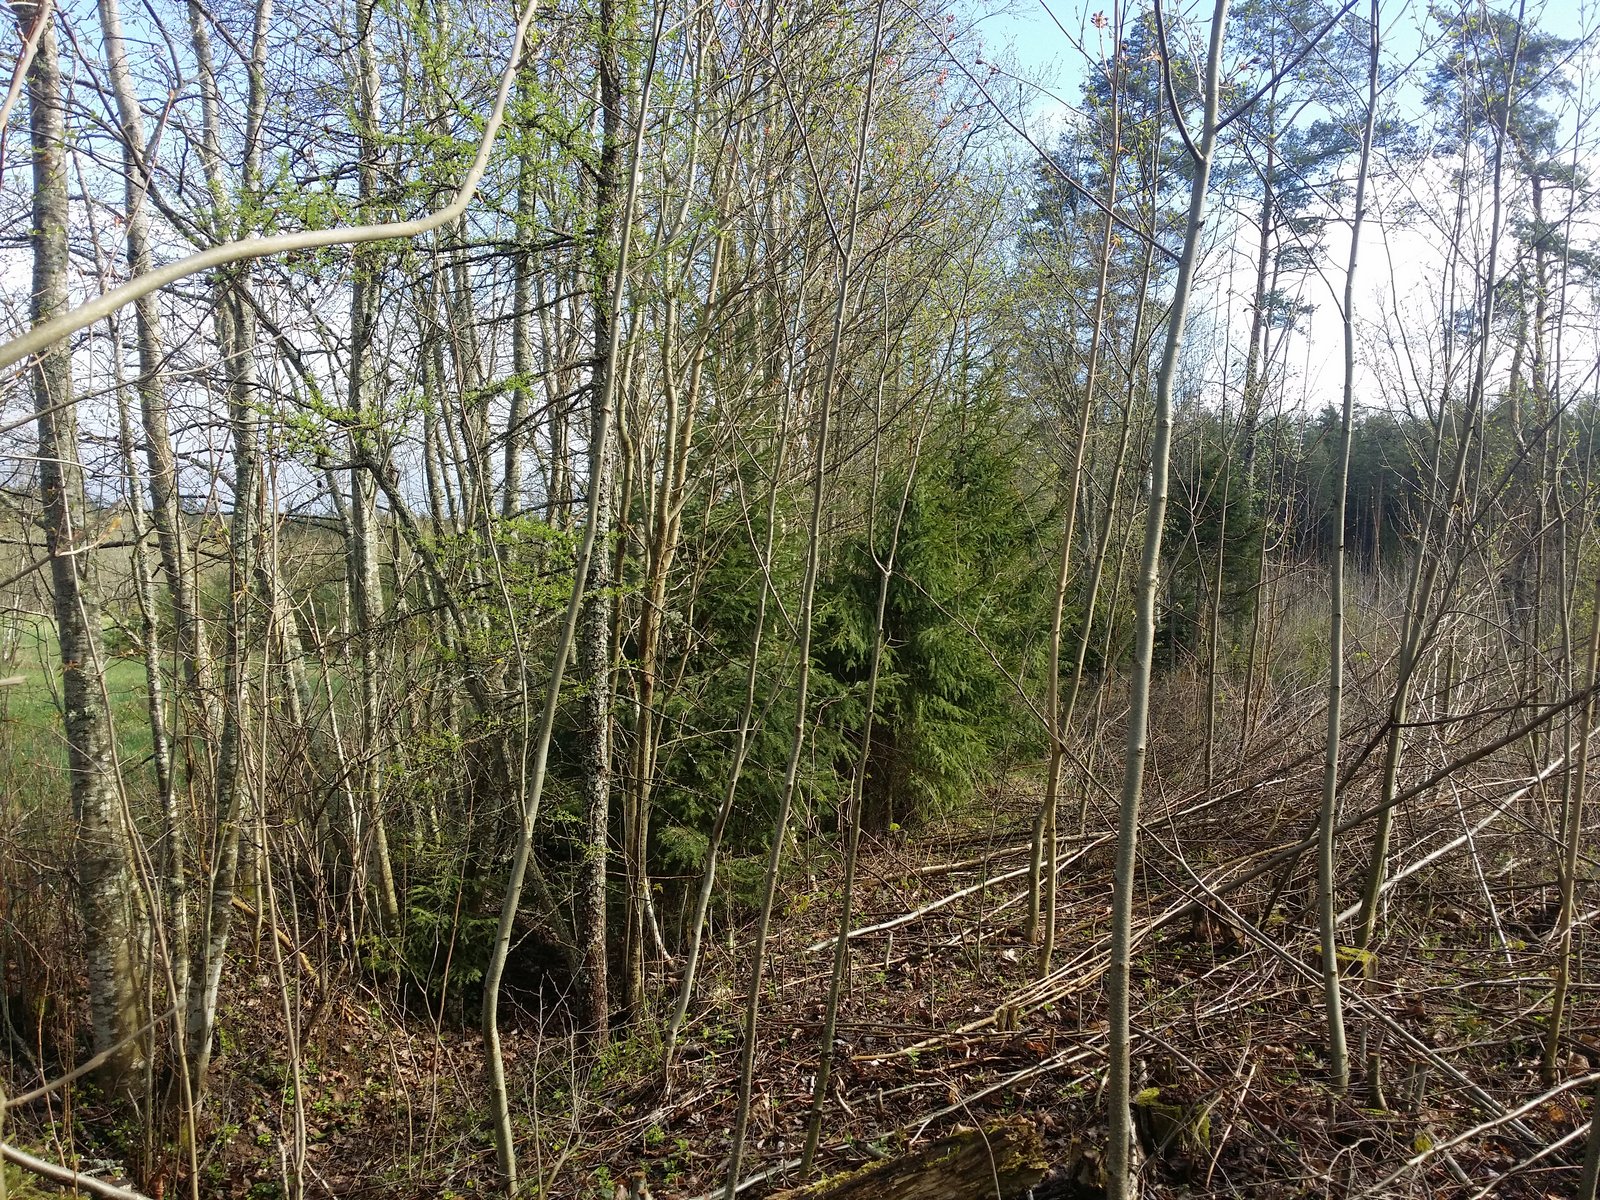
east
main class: Woodland
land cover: Broadleaved woodland
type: non-riverine alder, birch or aspen forest
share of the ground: 50 - 75 %
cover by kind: broadleaved forest trees 70 %, herbaceous plants 30 %
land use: Forestry
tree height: < 5 m
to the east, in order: Broadleaved woodland; Pine dominated mixed woodland; Other mixed woodland; Other coniferous woodland
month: May
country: LV
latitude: 57.3999
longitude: 25.9881
